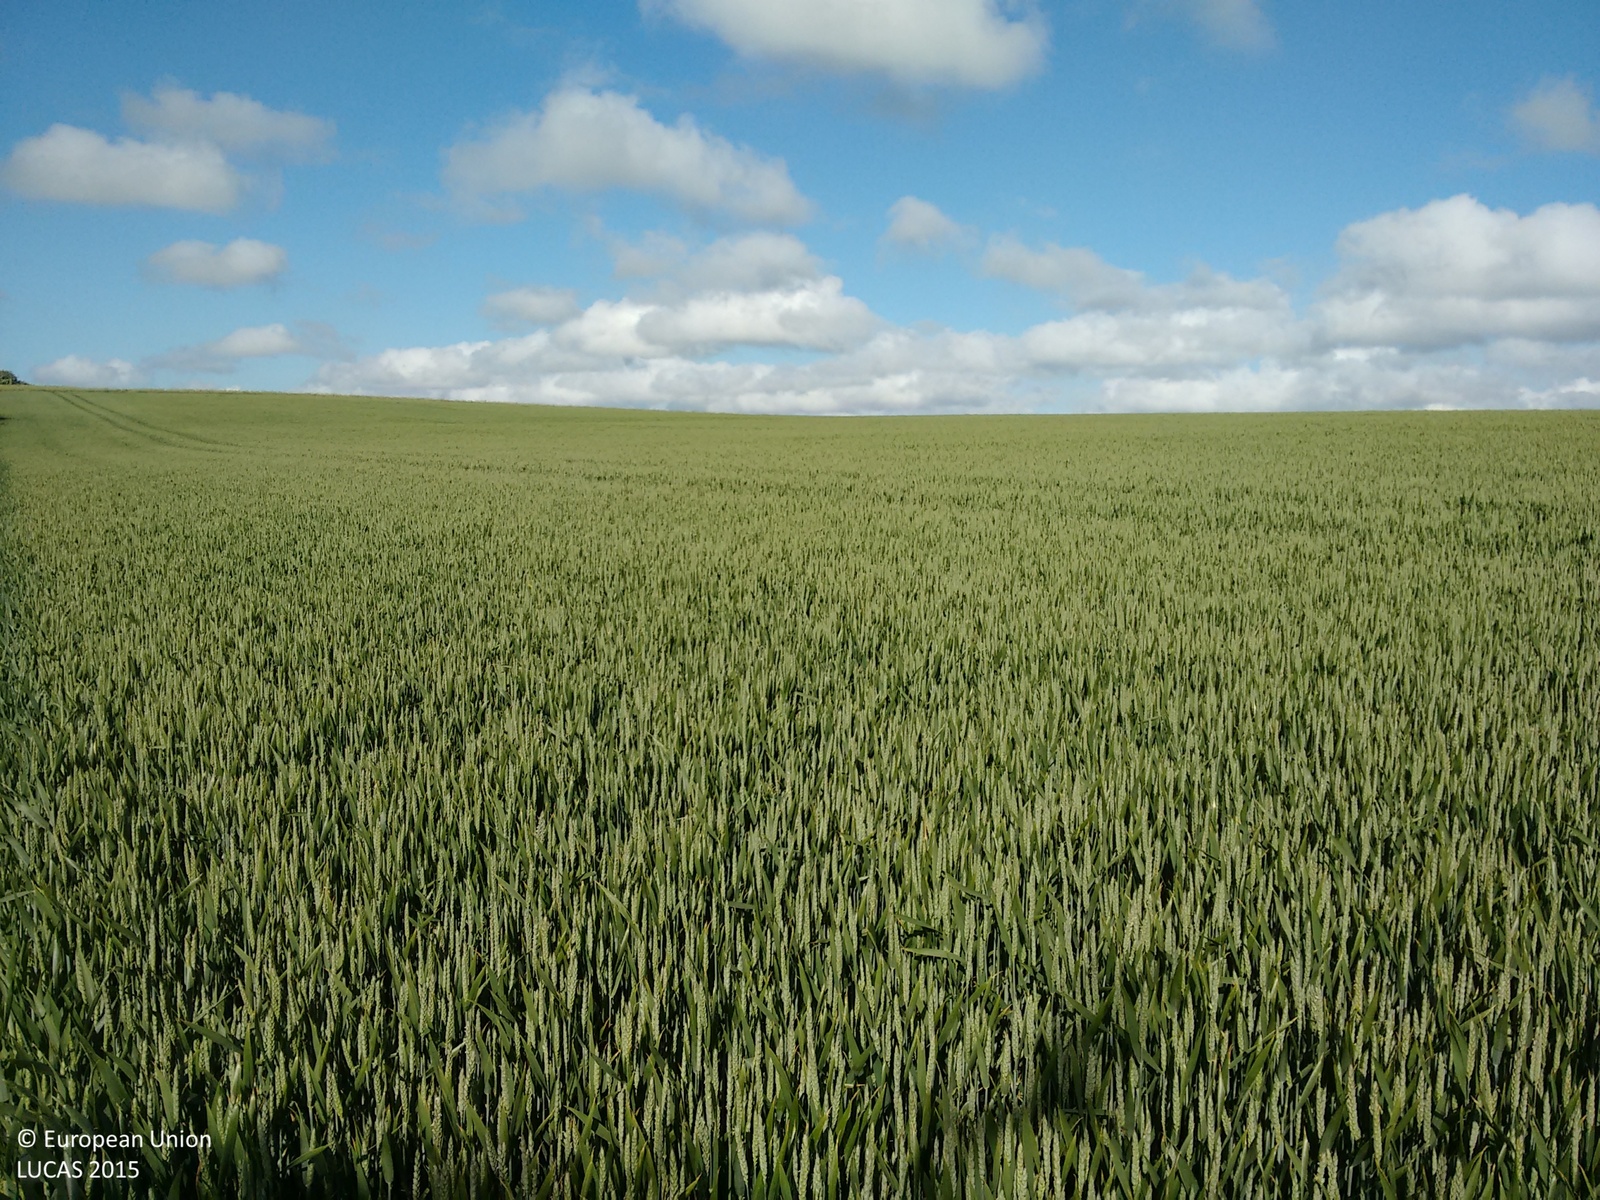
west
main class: Cropland
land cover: Common wheat
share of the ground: > 75 %
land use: Agriculture (excluding fallow land and kitchen gardens)
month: June
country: GB
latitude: 51.1513
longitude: -2.1410
